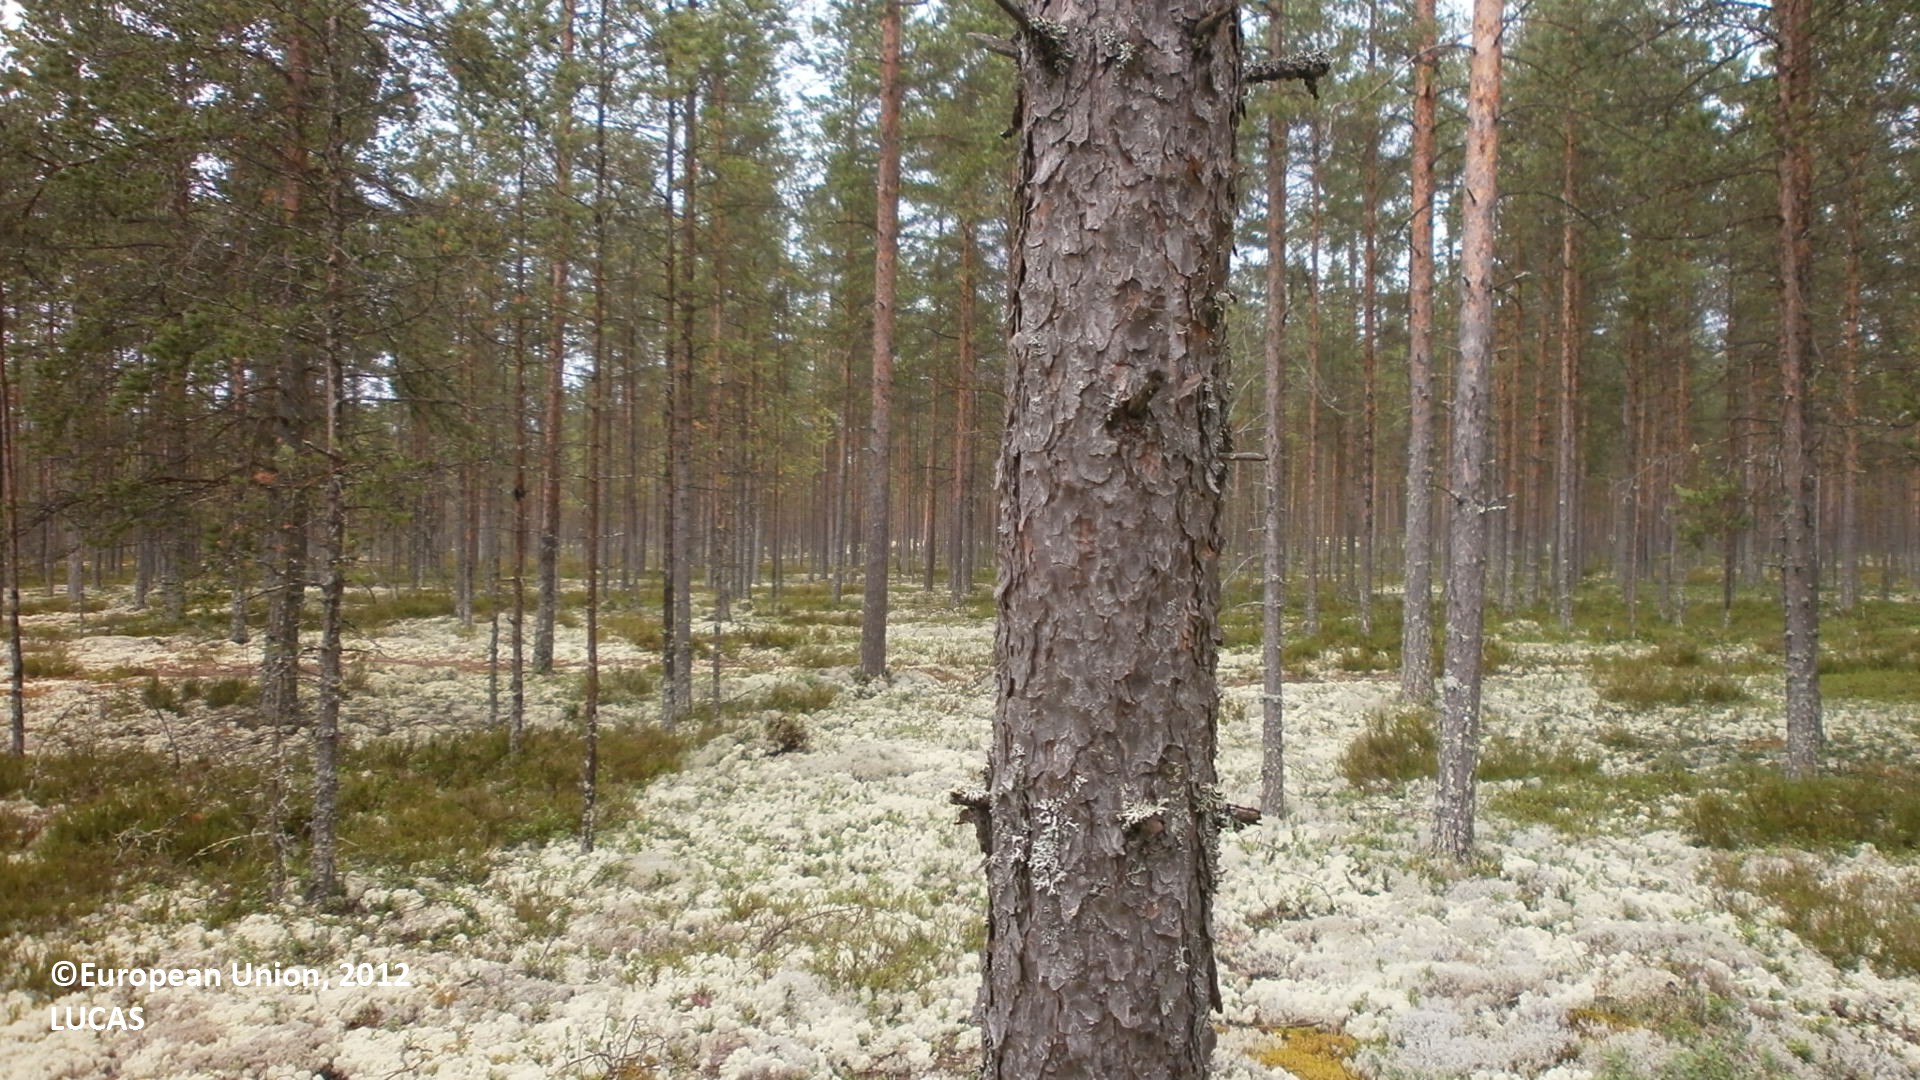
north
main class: Woodland
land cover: Pine dominated coniferous woodland
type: boreal forest
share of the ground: 50 - 75 %
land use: Forestry
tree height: > 5 m
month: July
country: FI
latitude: 64.1368
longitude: 23.8479
